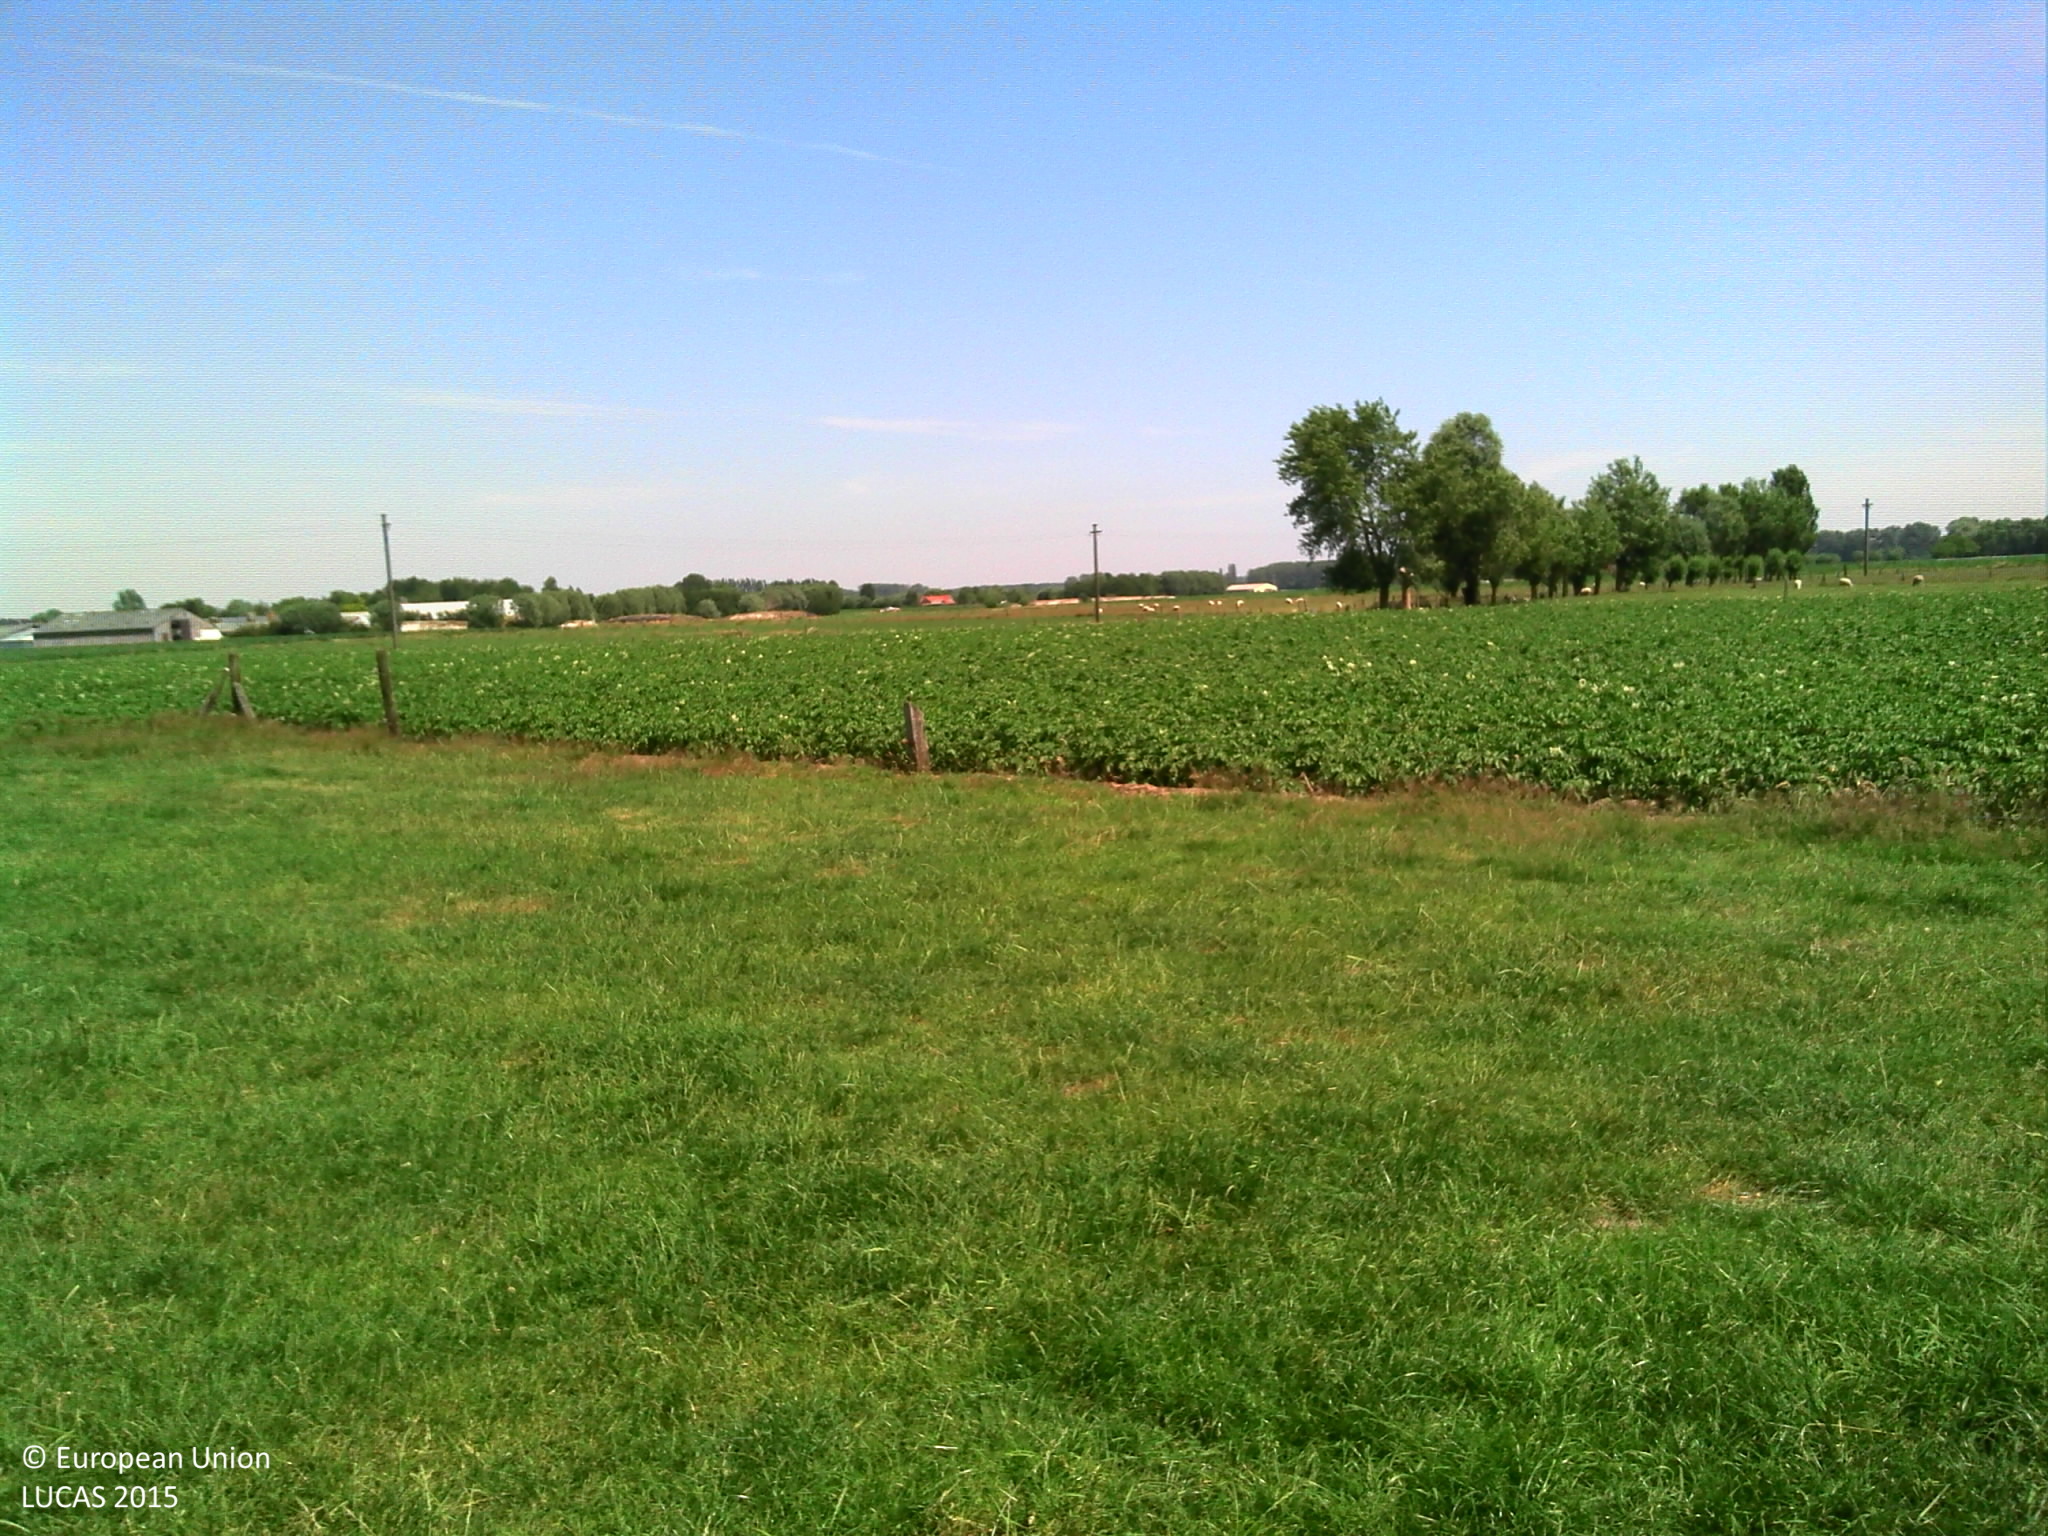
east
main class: Grassland
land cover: Grassland without tree/shrub cover
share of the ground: > 75 %
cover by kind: herbaceous plants 100 %
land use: Agriculture (excluding fallow land and kitchen gardens)
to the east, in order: Grassland without tree/shrub cover; Fences; Potatoes; Fences; Grassland without tree/shrub cover; Fences; Grassland without tree/shrub cover; Fences; Grassland without tree/shrub cover; Electric lines; Grassland without tree/shrub cover; Fences; Grassland without tree/shrub cover
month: July
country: BE
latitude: 51.1119
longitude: 3.4068
